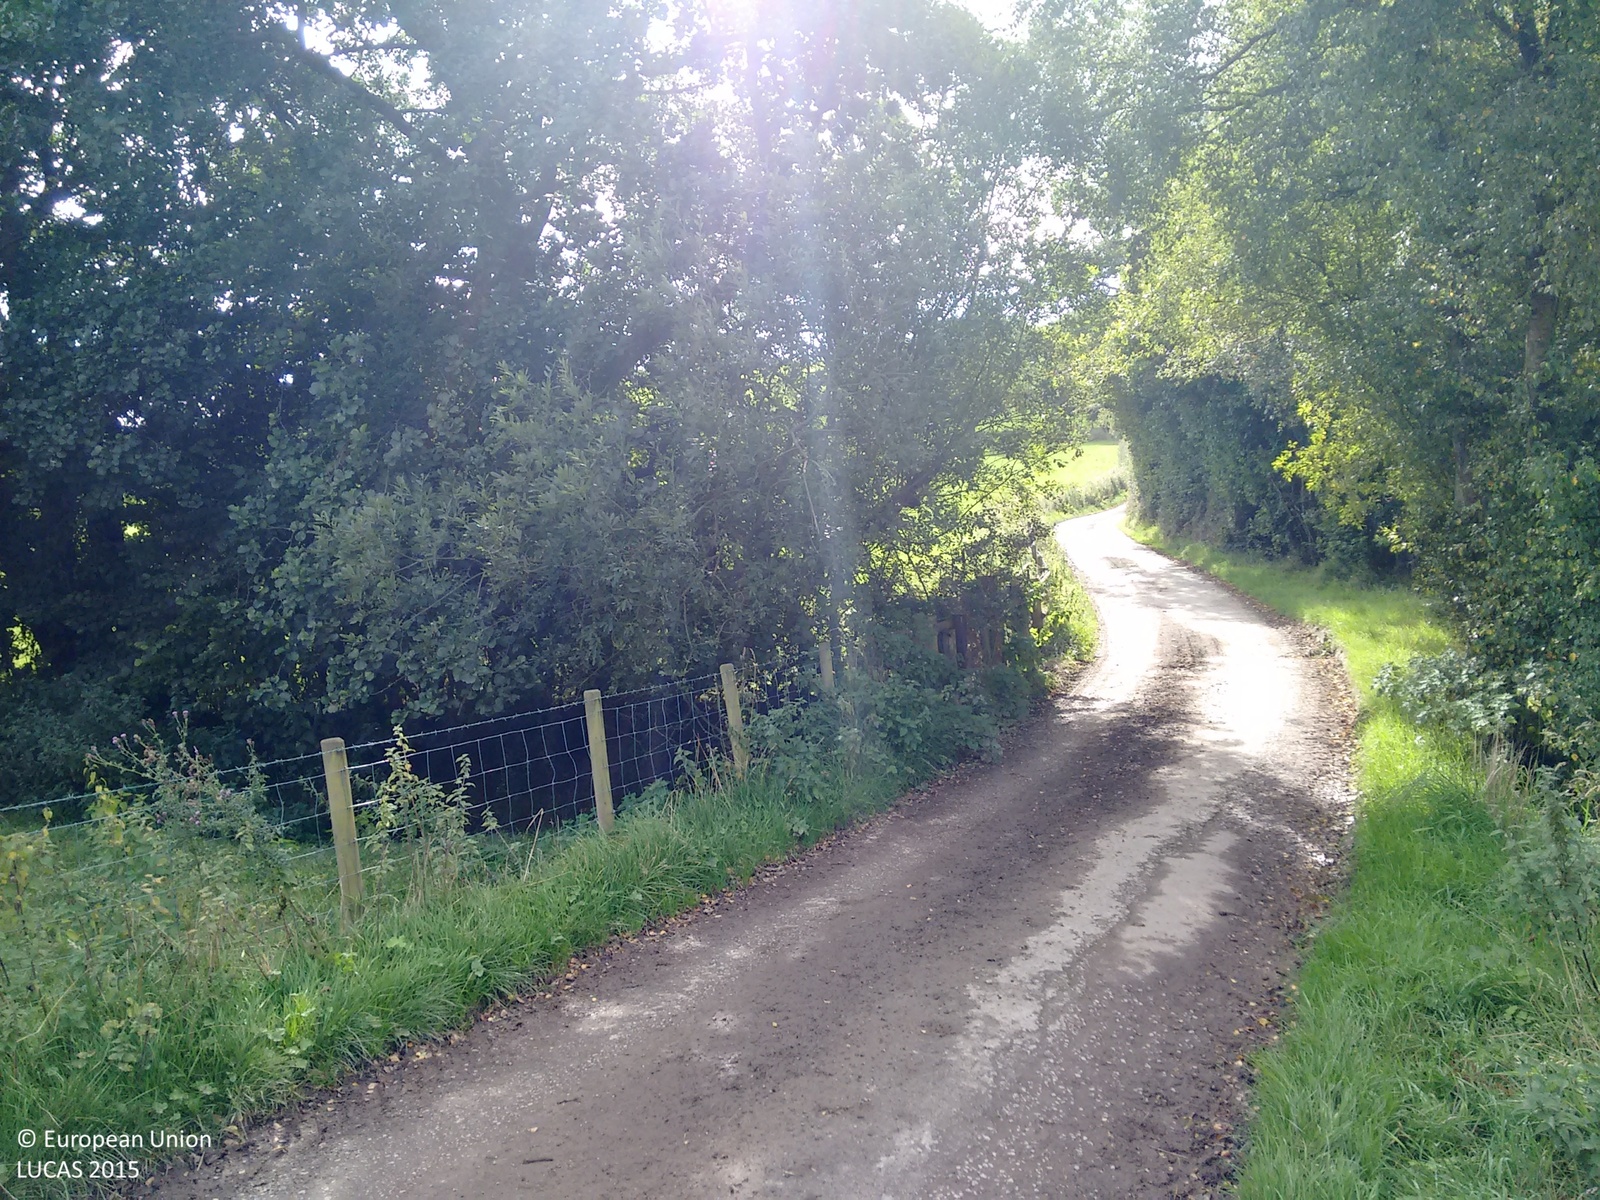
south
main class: Grassland
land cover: Grassland without tree/shrub cover
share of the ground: > 75 %
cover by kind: herbaceous plants 100 %
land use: Agriculture (excluding fallow land and kitchen gardens)
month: September
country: GB
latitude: 53.0710
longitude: -3.4104
